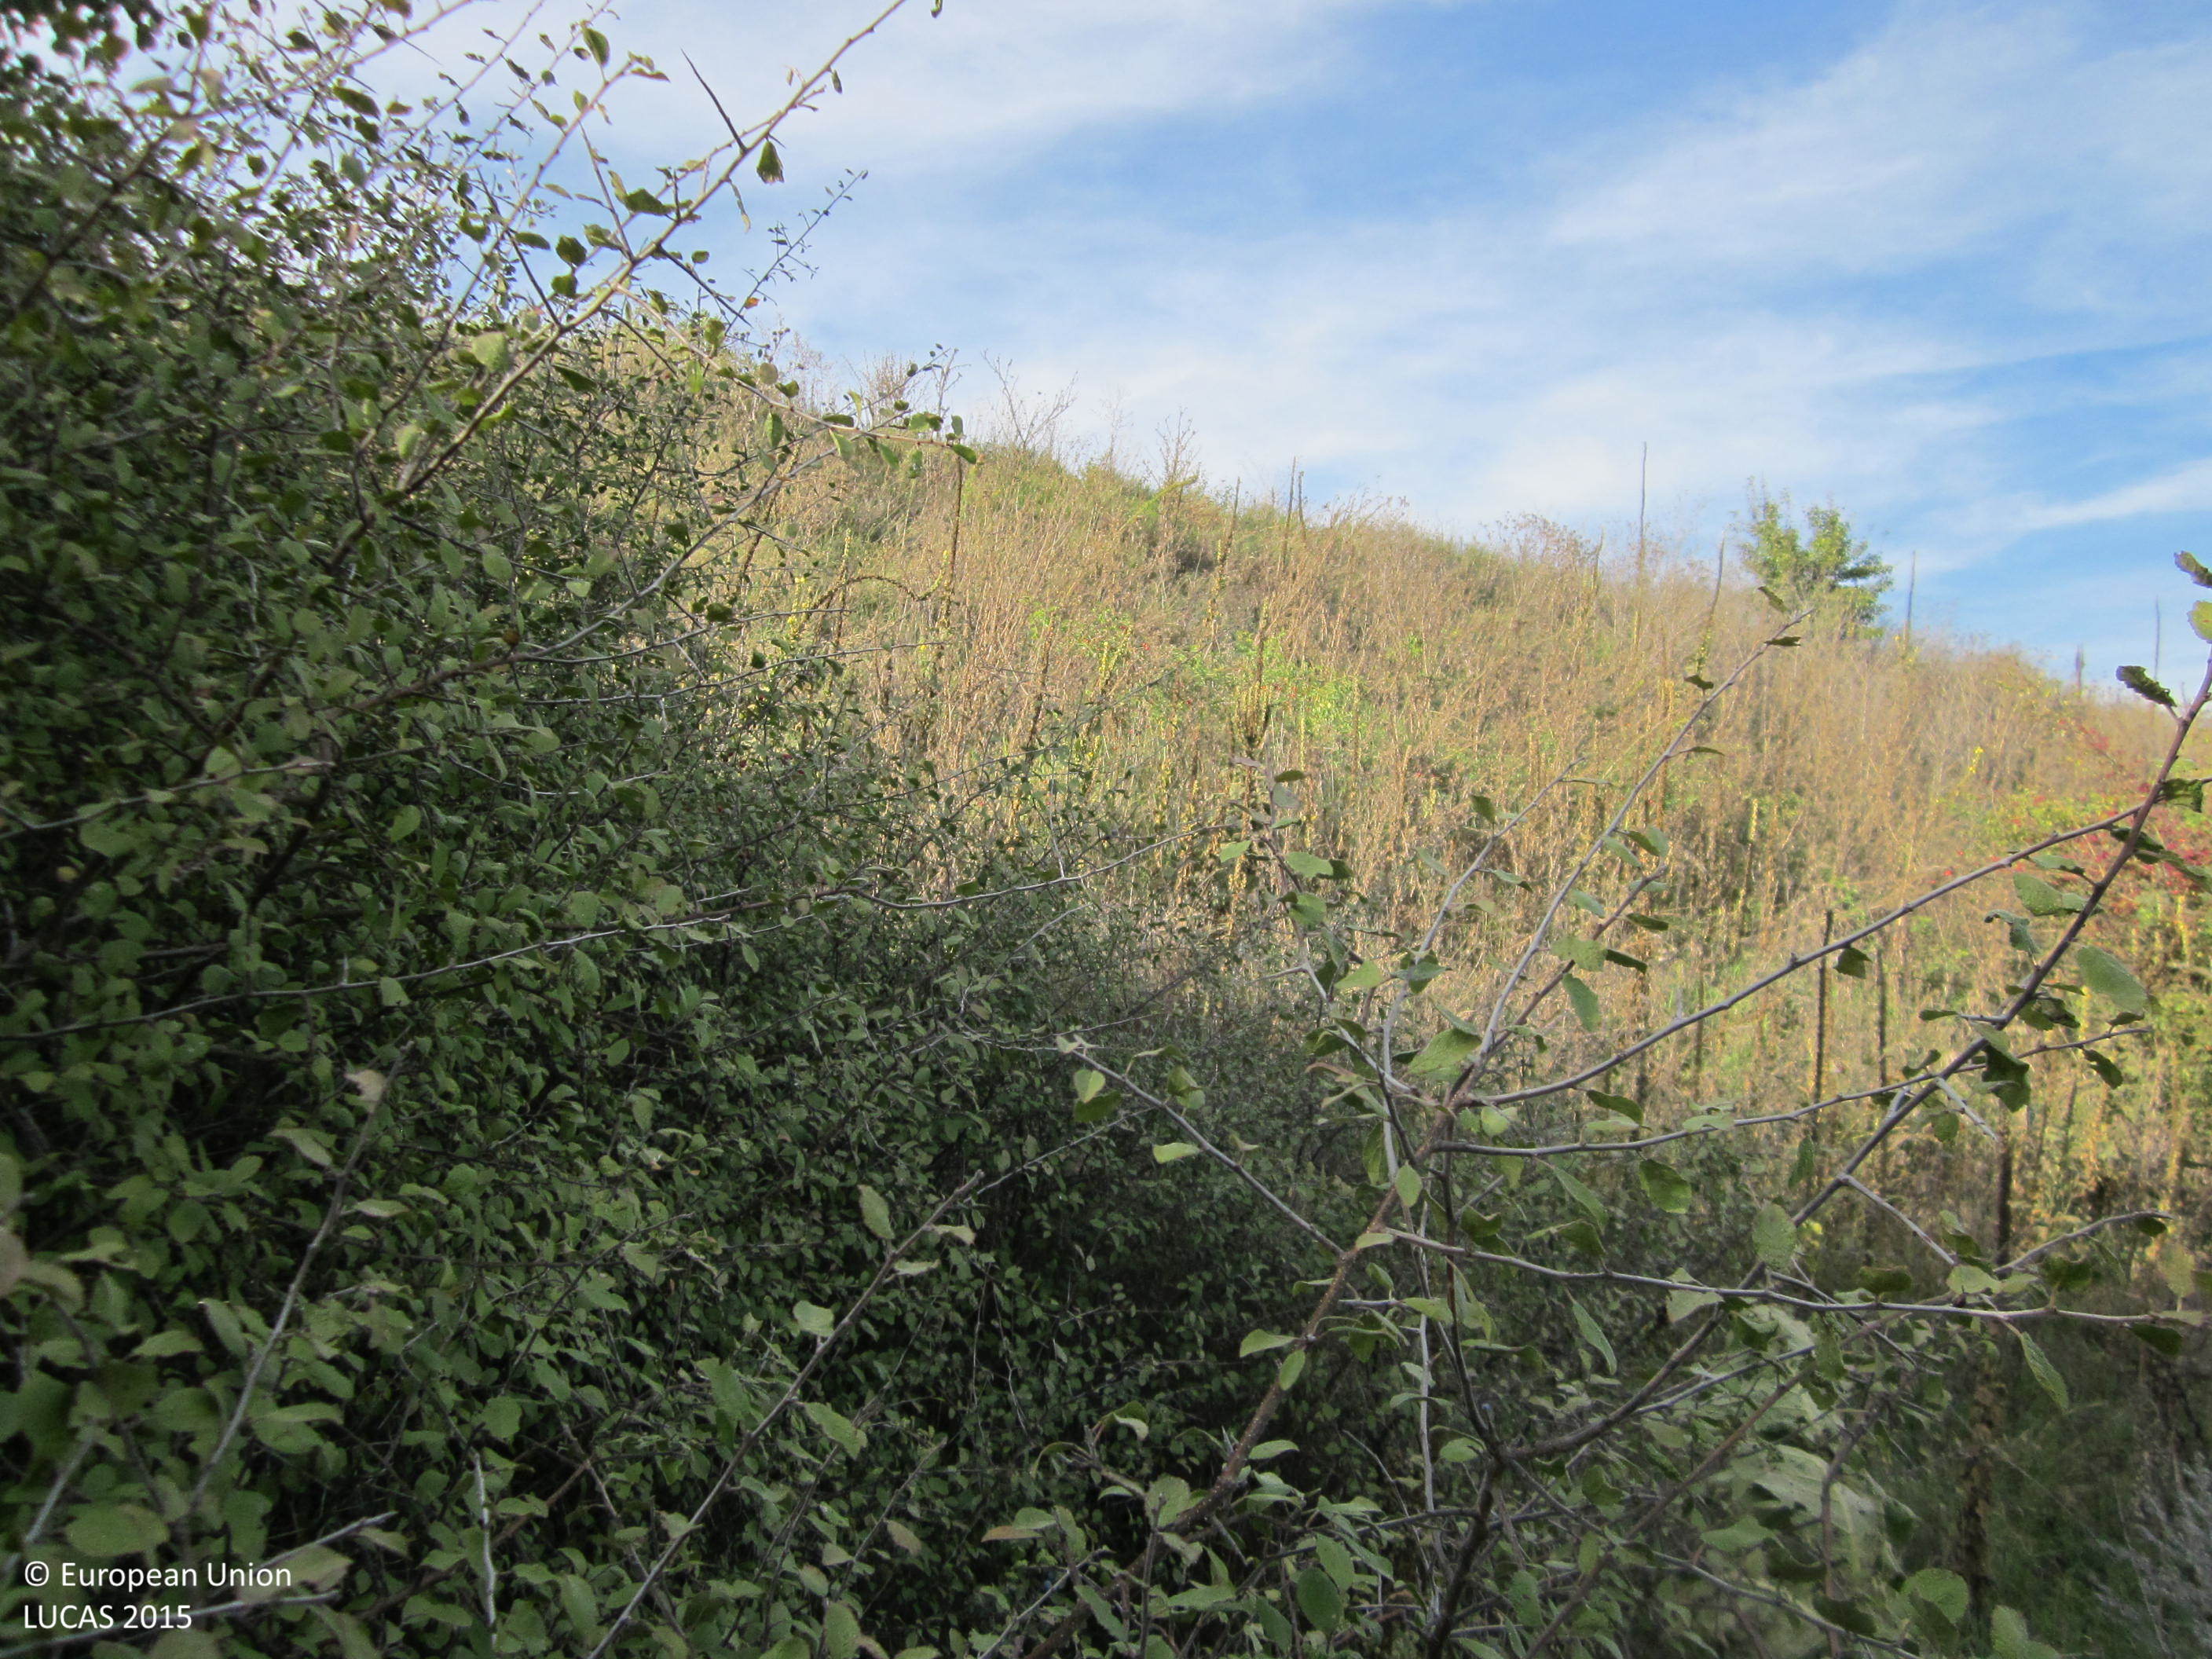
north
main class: Shrubland
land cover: Shrubland with sparse tree cover
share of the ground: 50 - 75 %
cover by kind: shrubs 55 %, herbaceous plants 40 %, broadleaved forest trees 5 %
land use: Semi-natural and natural areas not in use
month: October
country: BG
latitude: 42.7786
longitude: 26.8374
